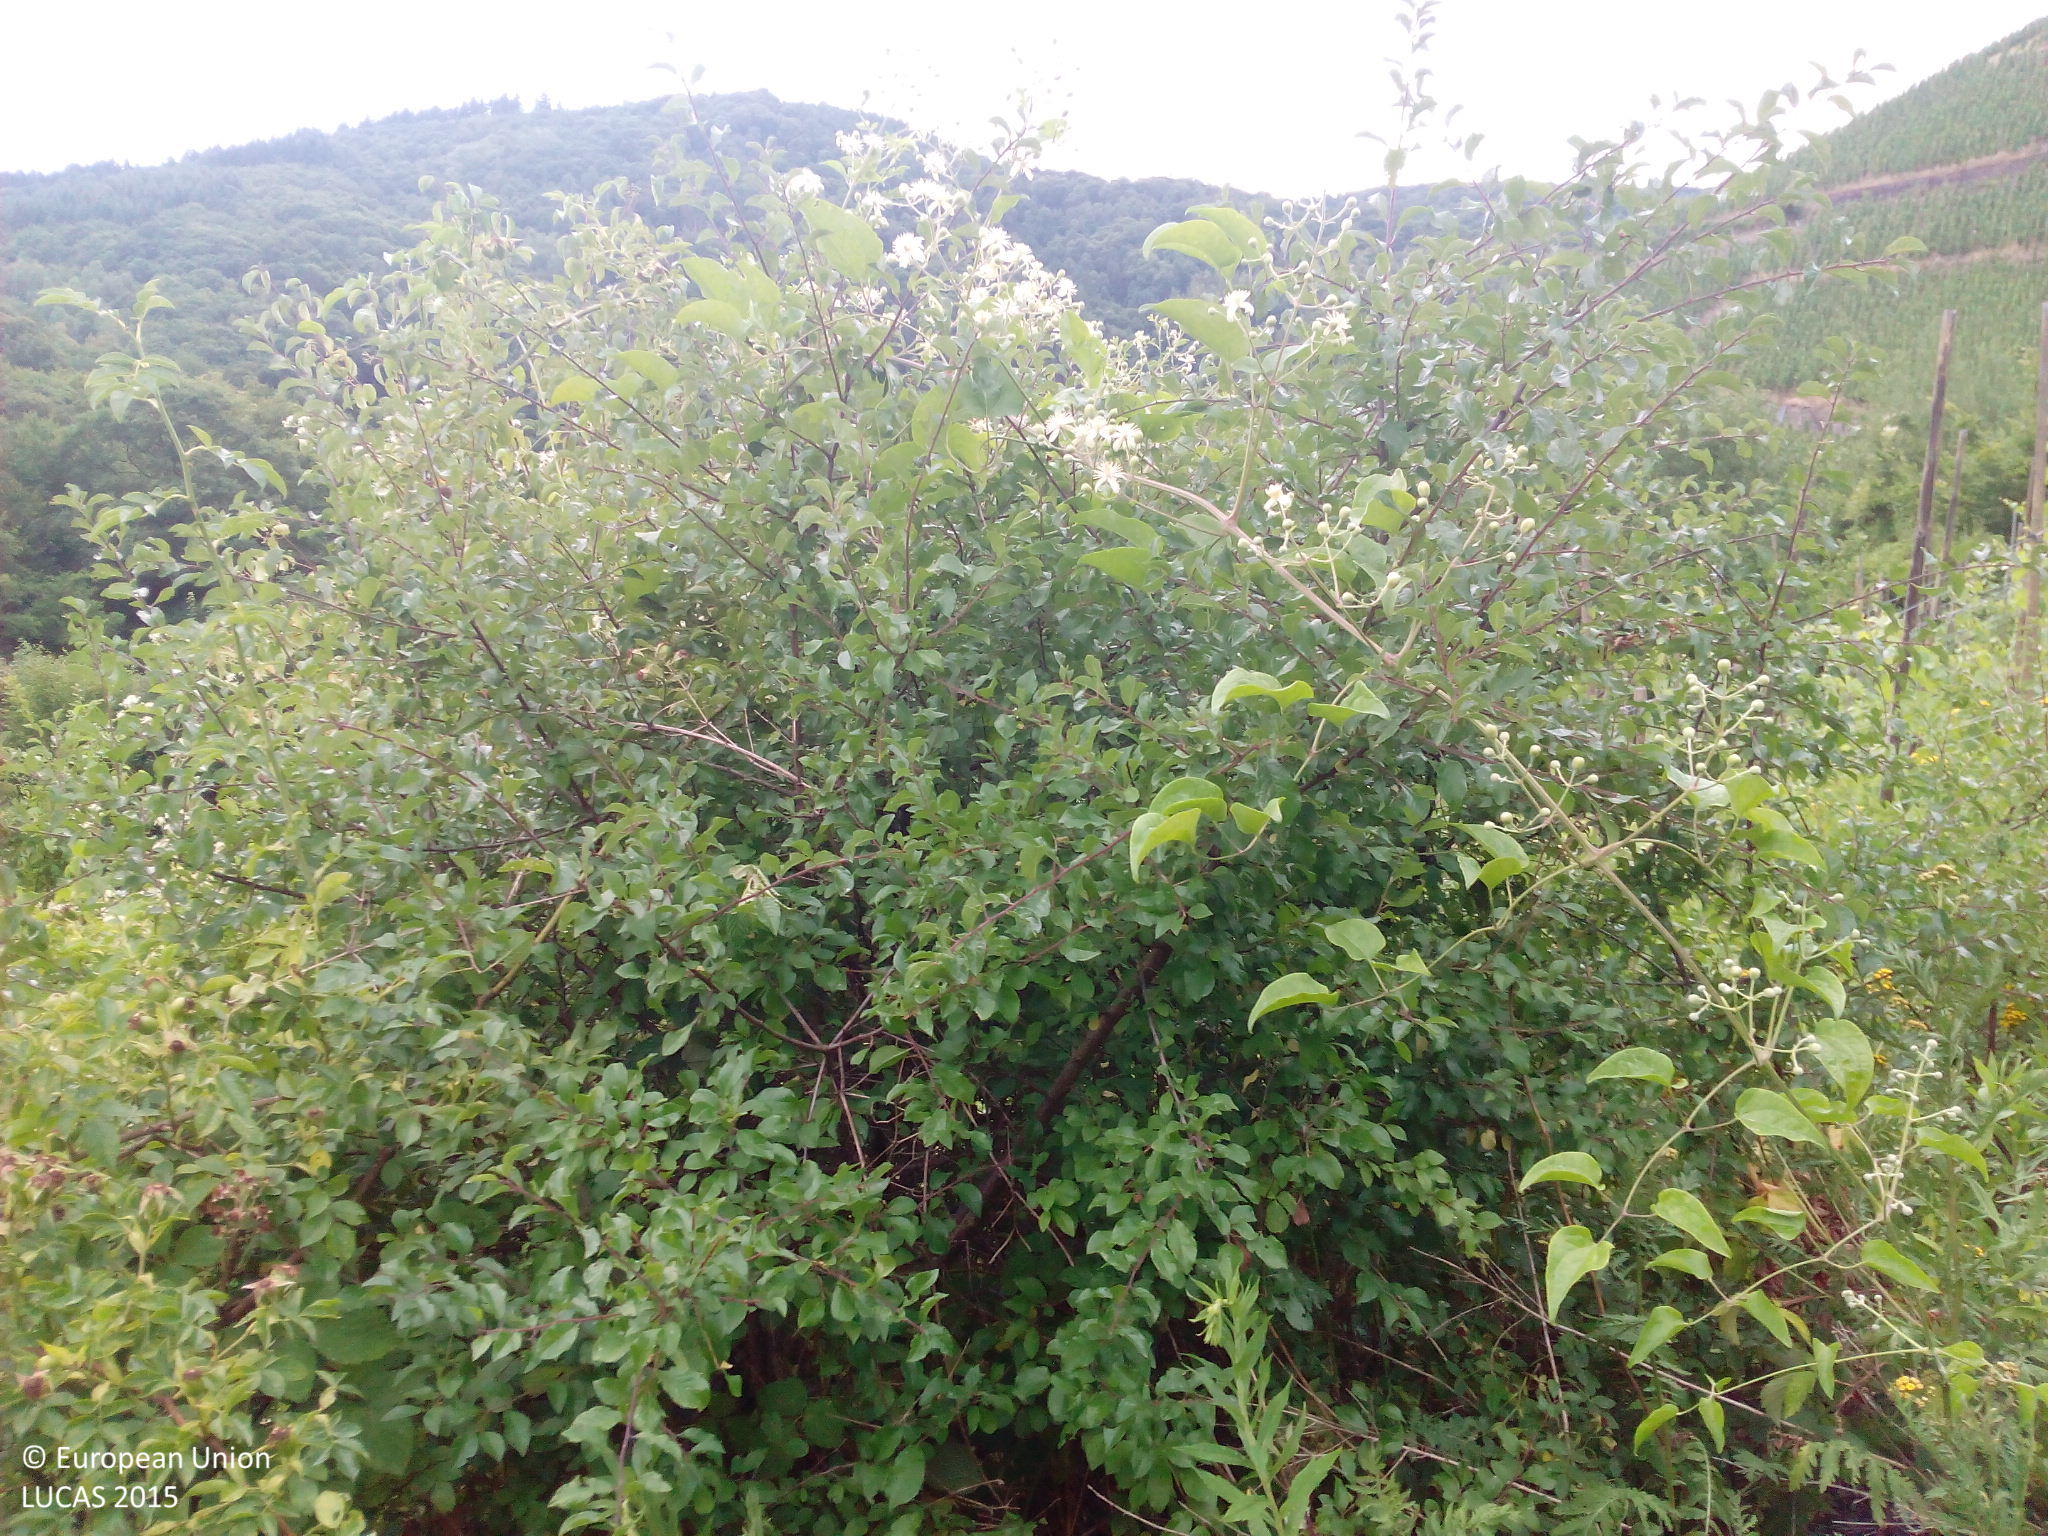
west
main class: Shrubland
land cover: Shrubland with sparse tree cover
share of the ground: > 75 %
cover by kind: shrubs 70 %, herbaceous plants 25 %, broadleaved forest trees 5 %
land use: Abandoned areas
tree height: < 5 m
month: July
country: DE
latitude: 49.9319
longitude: 7.1164
